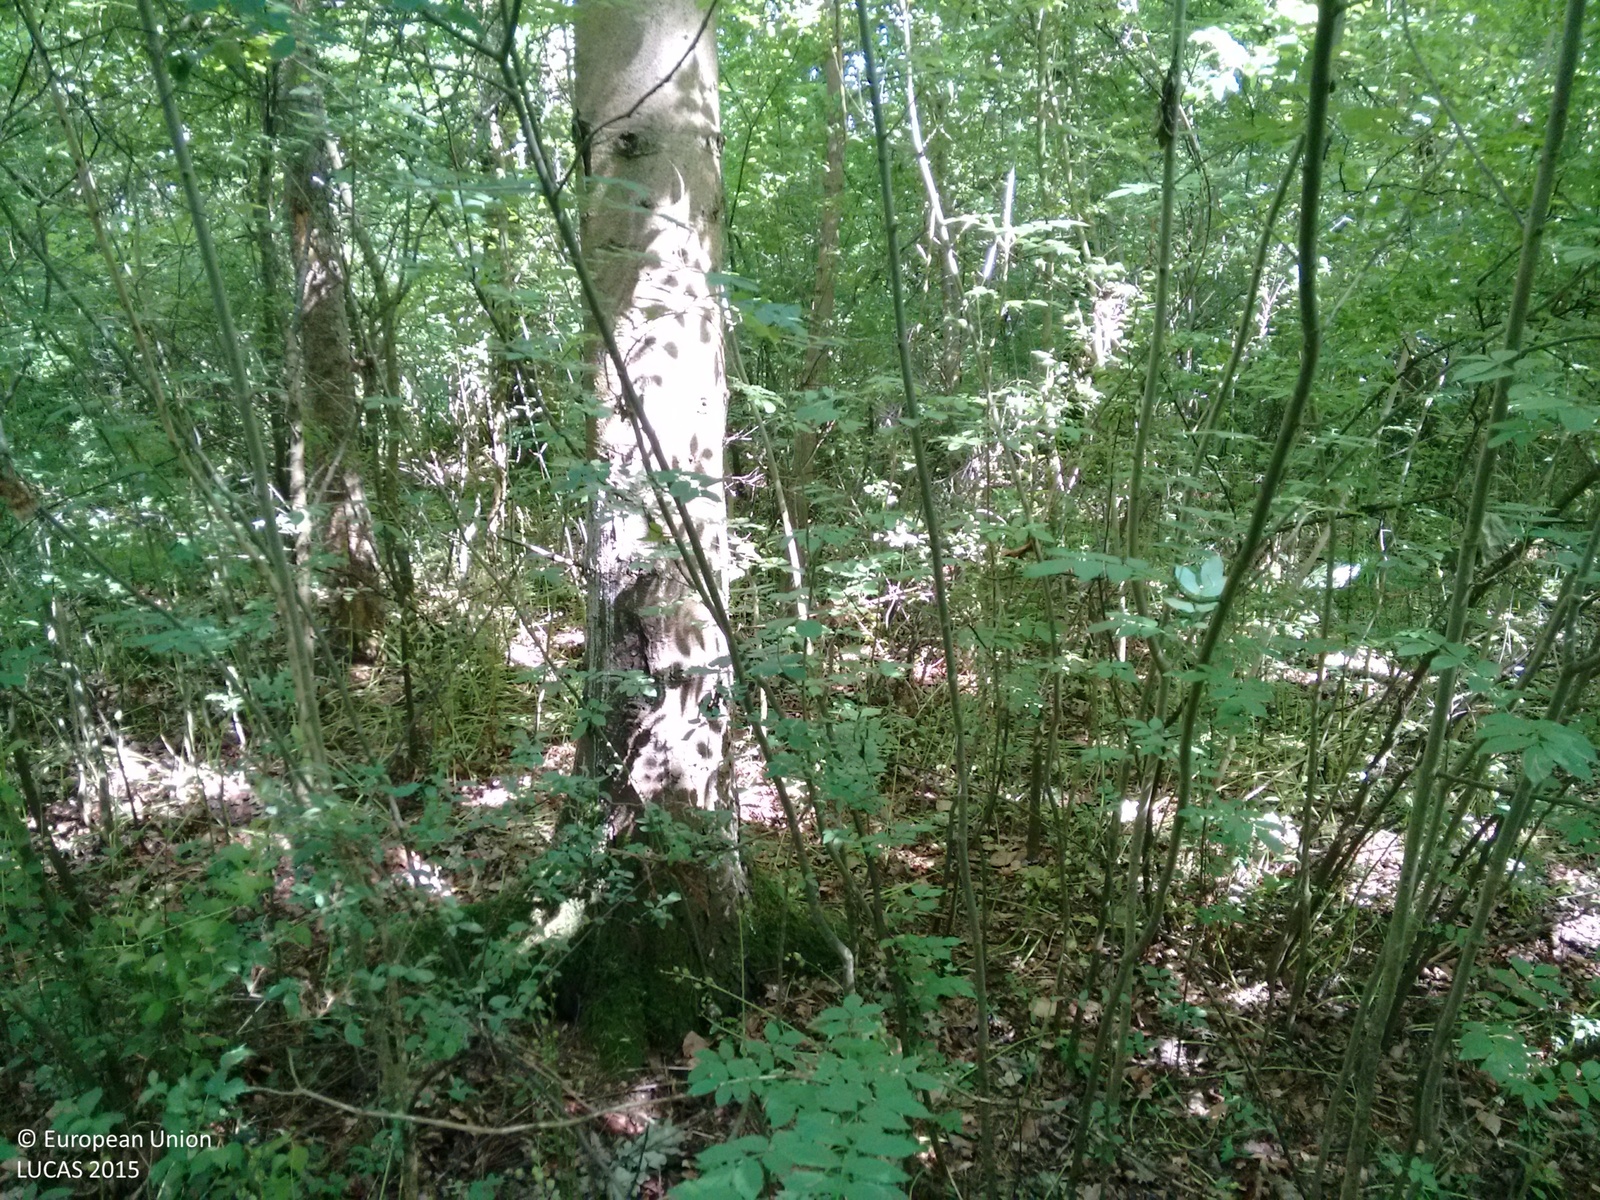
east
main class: Woodland
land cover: Broadleaved woodland
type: mesophytic deciduous forest
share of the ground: > 75 %
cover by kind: broadleaved forest trees 80 %, coniferous forest trees 20 %
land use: Forestry
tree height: > 5 m
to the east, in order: Broadleaved woodland; Grass margins; Tracks; Grass margins; Broadleaved woodland; Tracks; Broadleaved woodland; Inland fresh running water; Managed hedges; Grassland without tree/shrub cover
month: June
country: GB
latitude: 51.3429
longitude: -2.2215
